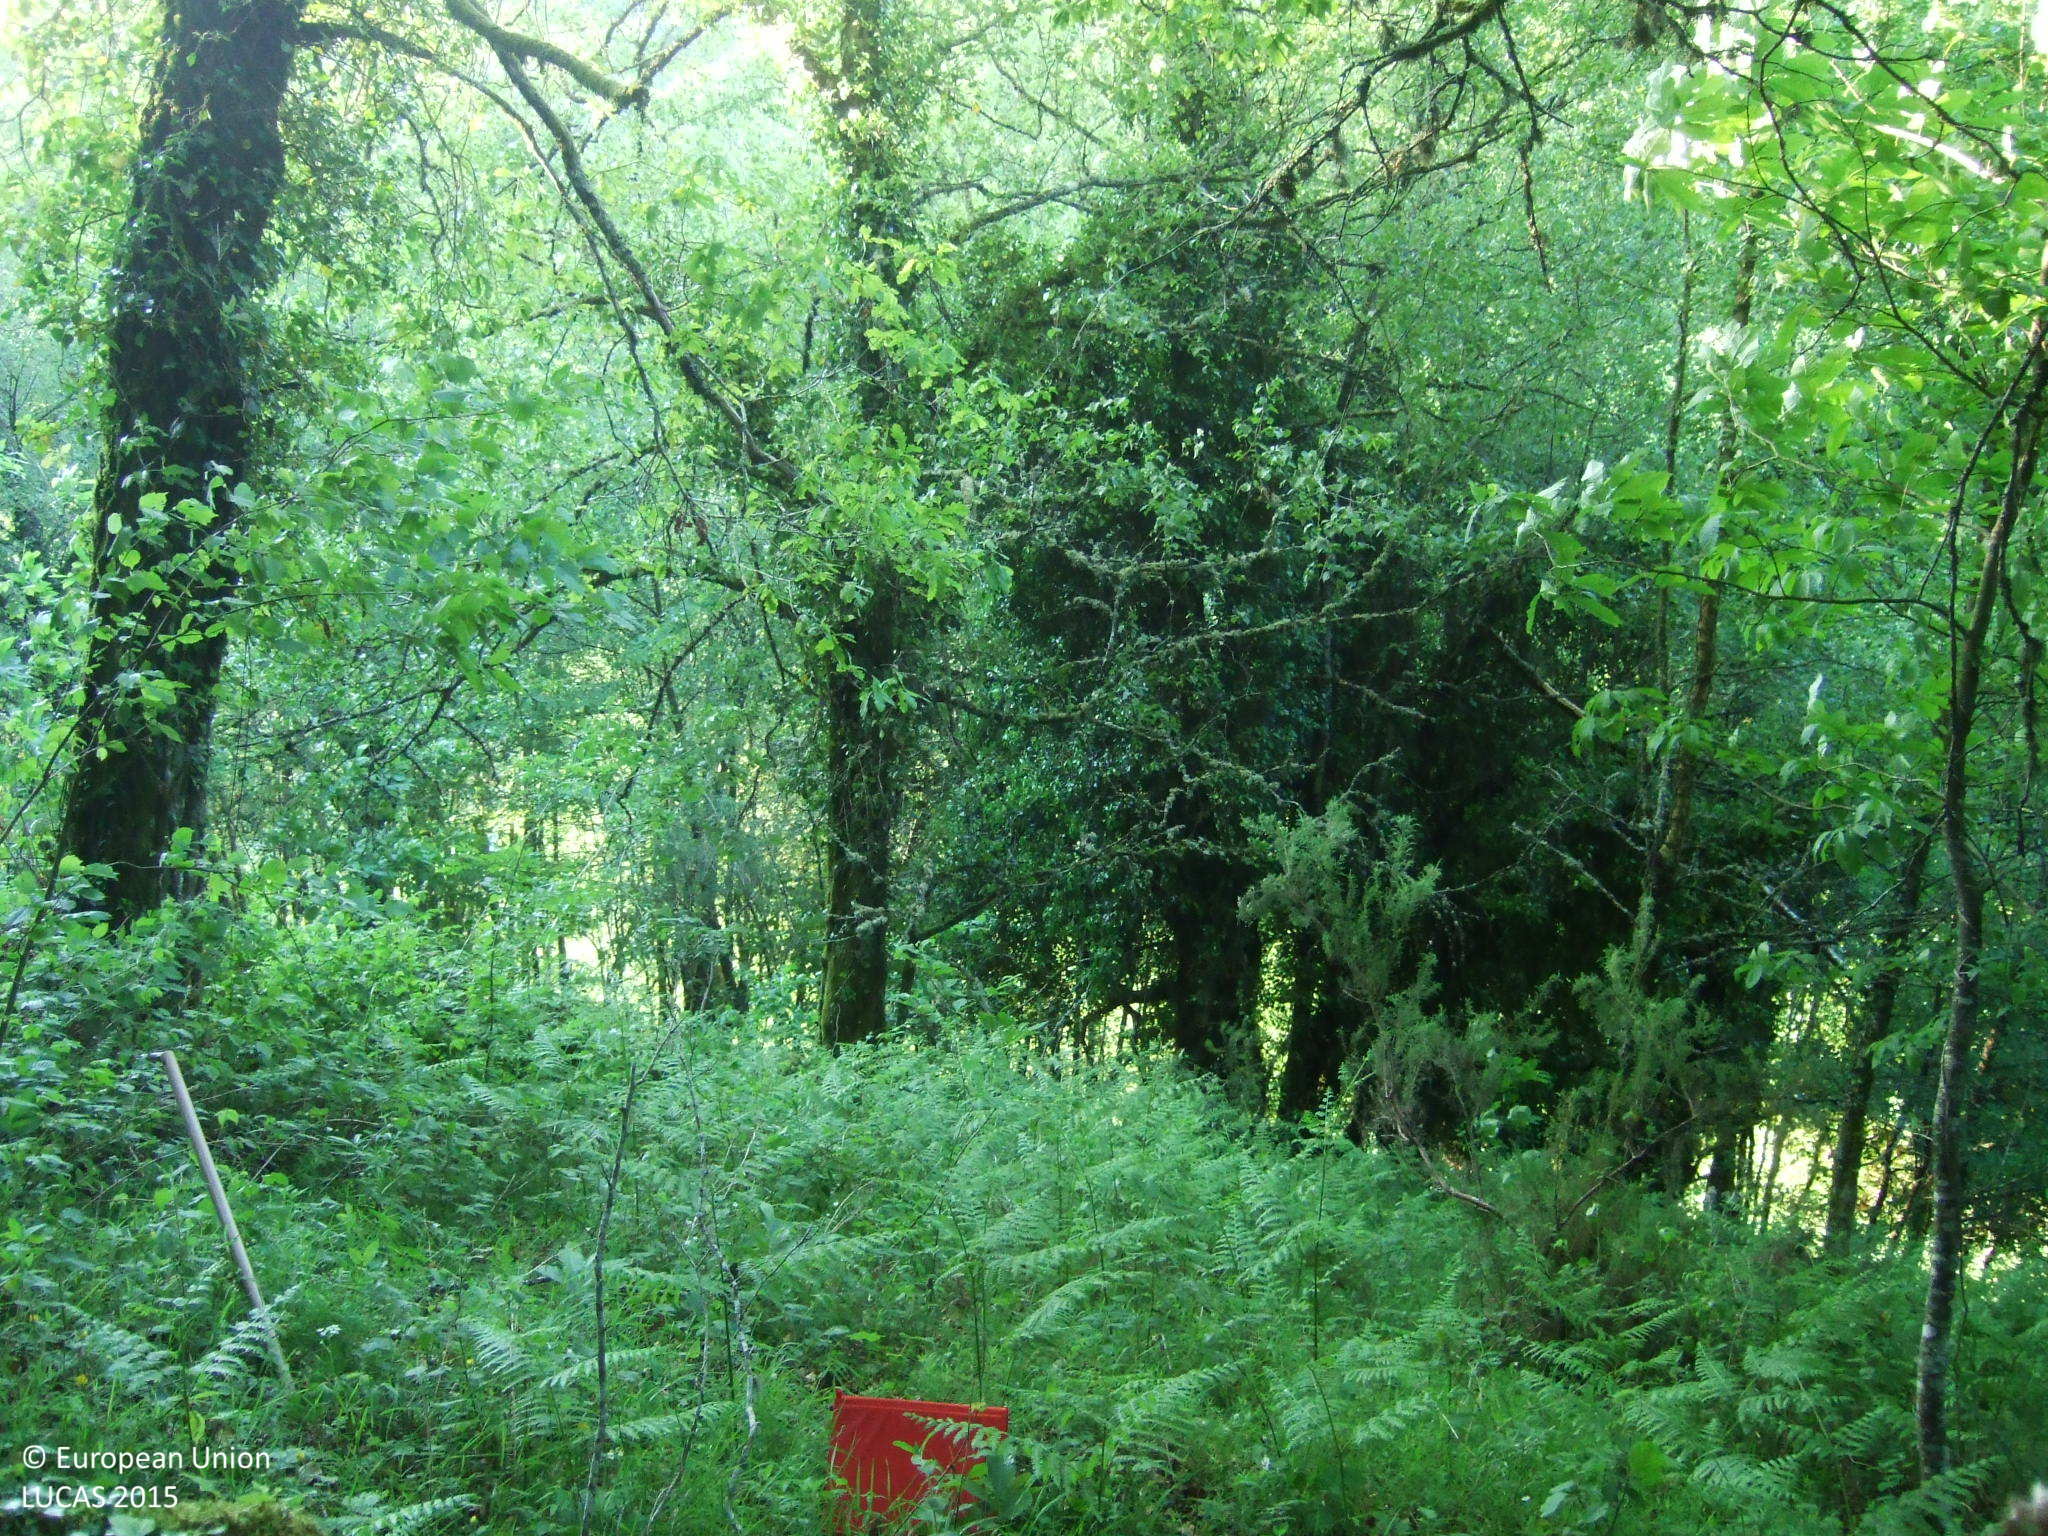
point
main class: Woodland
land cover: Broadleaved woodland
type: acidophilous oak and oak-birch forest
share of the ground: > 75 %
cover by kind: broadleaved forest trees 80 %, shrubs 20 %
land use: Forestry
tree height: > 5 m
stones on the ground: < 10 %
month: May
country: ES
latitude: 42.7012
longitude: -7.2912
